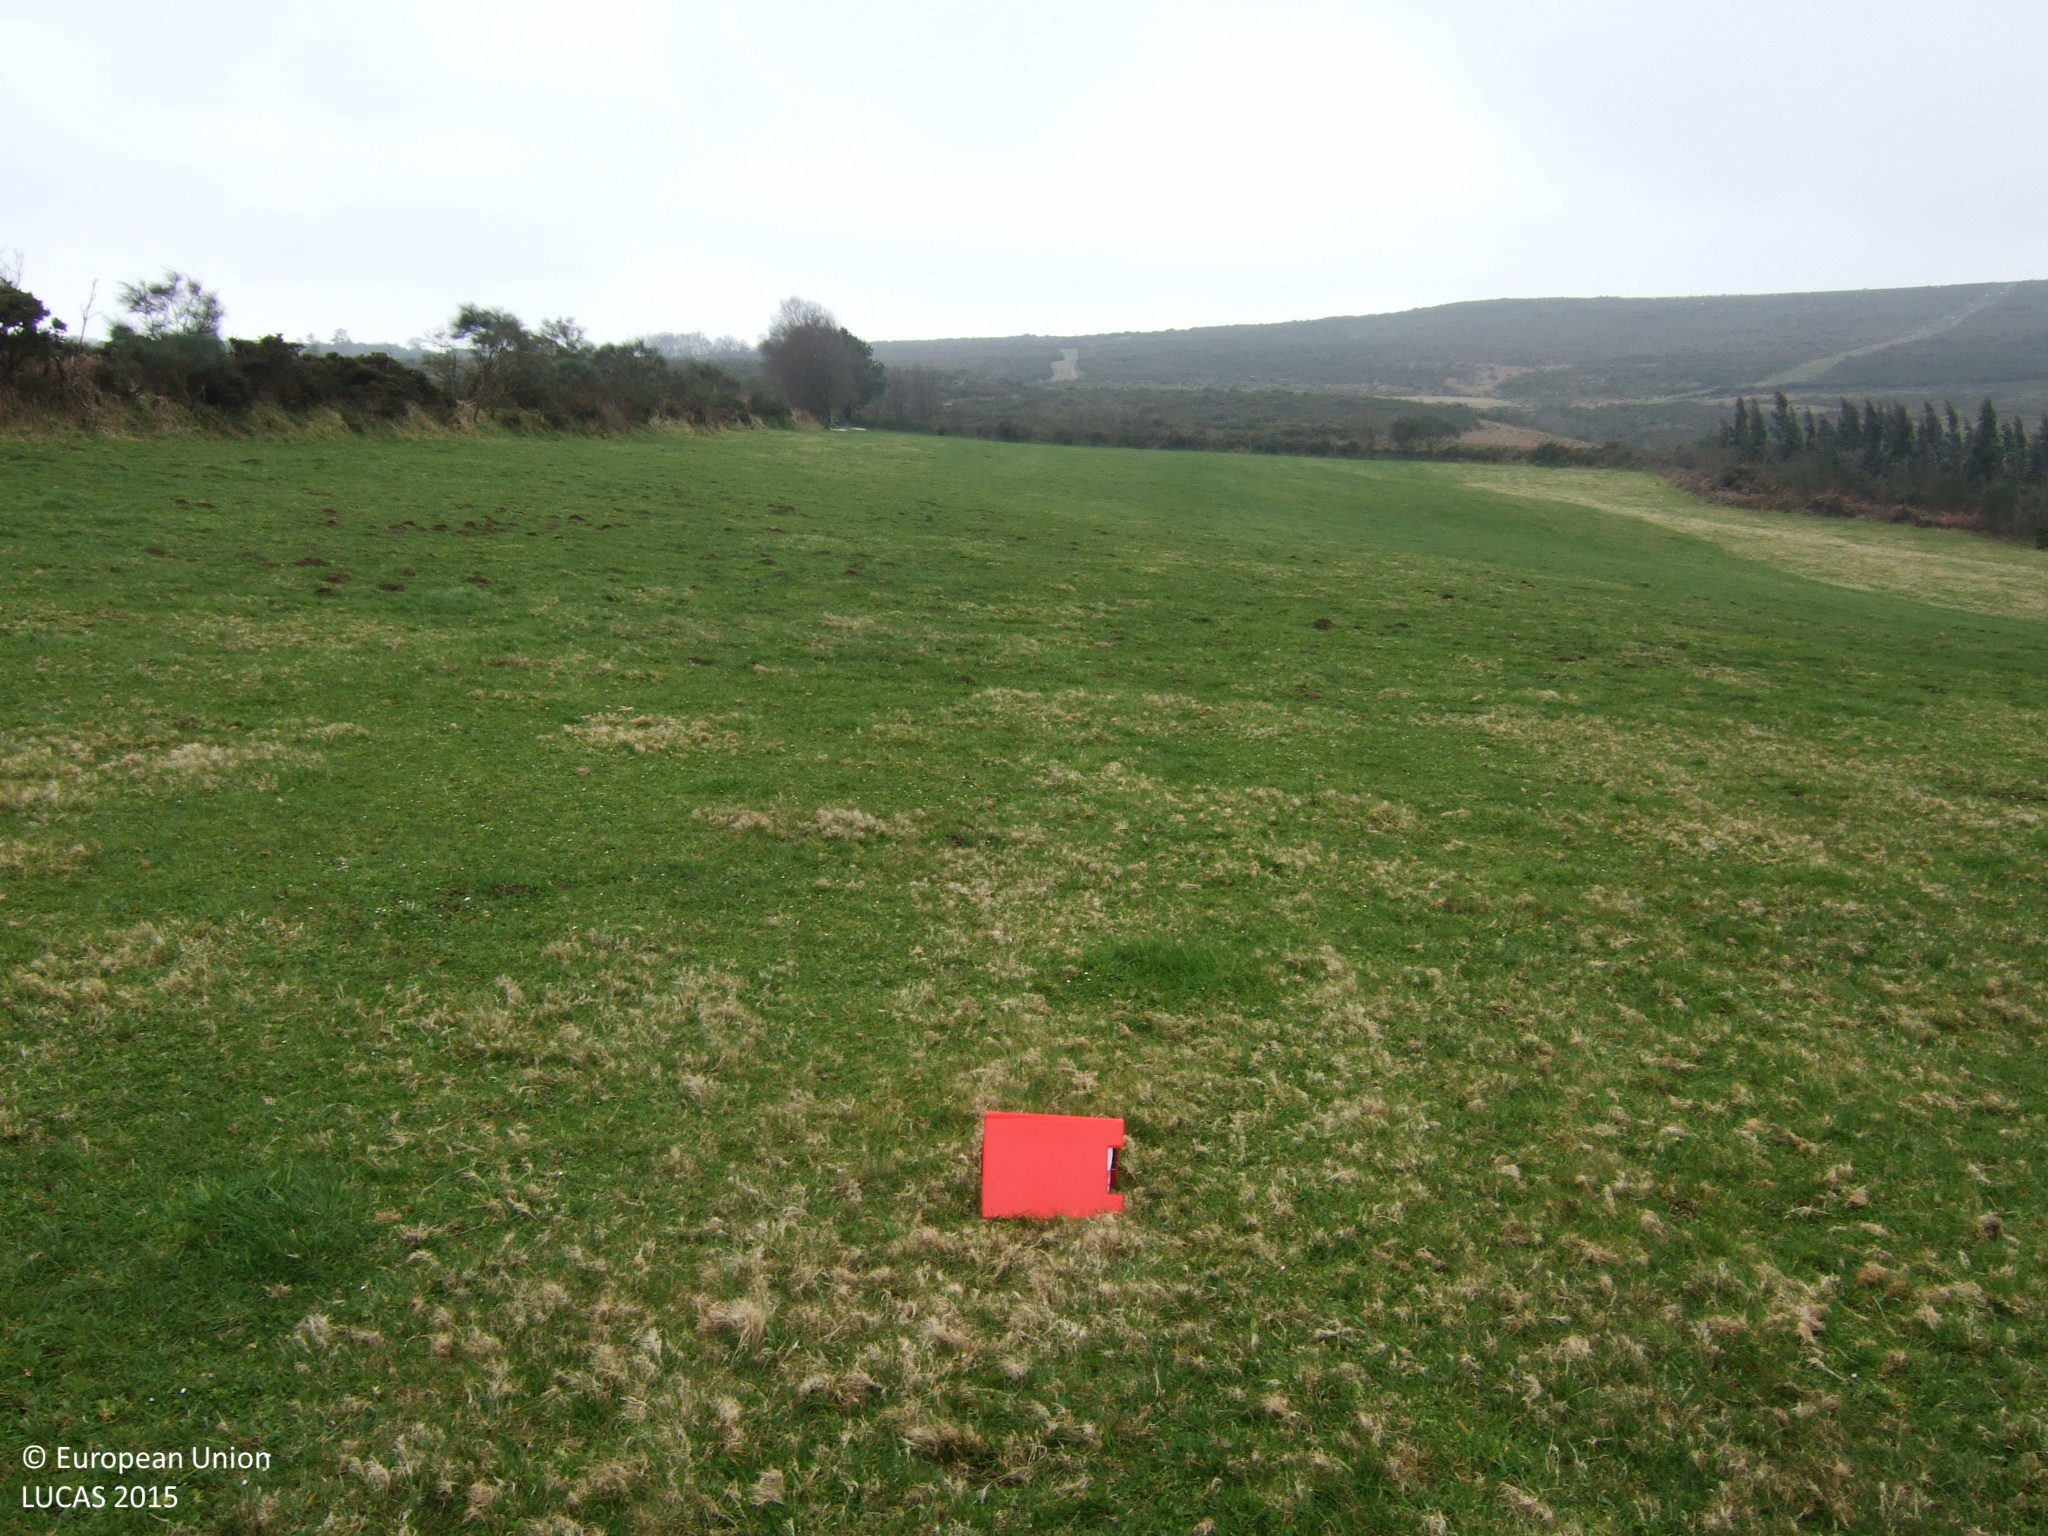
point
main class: Grassland
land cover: Grassland without tree/shrub cover
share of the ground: > 75 %
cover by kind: herbaceous plants 100 %
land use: Agriculture (excluding fallow land and kitchen gardens)
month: March
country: ES
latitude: 42.9673
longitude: -7.8753
